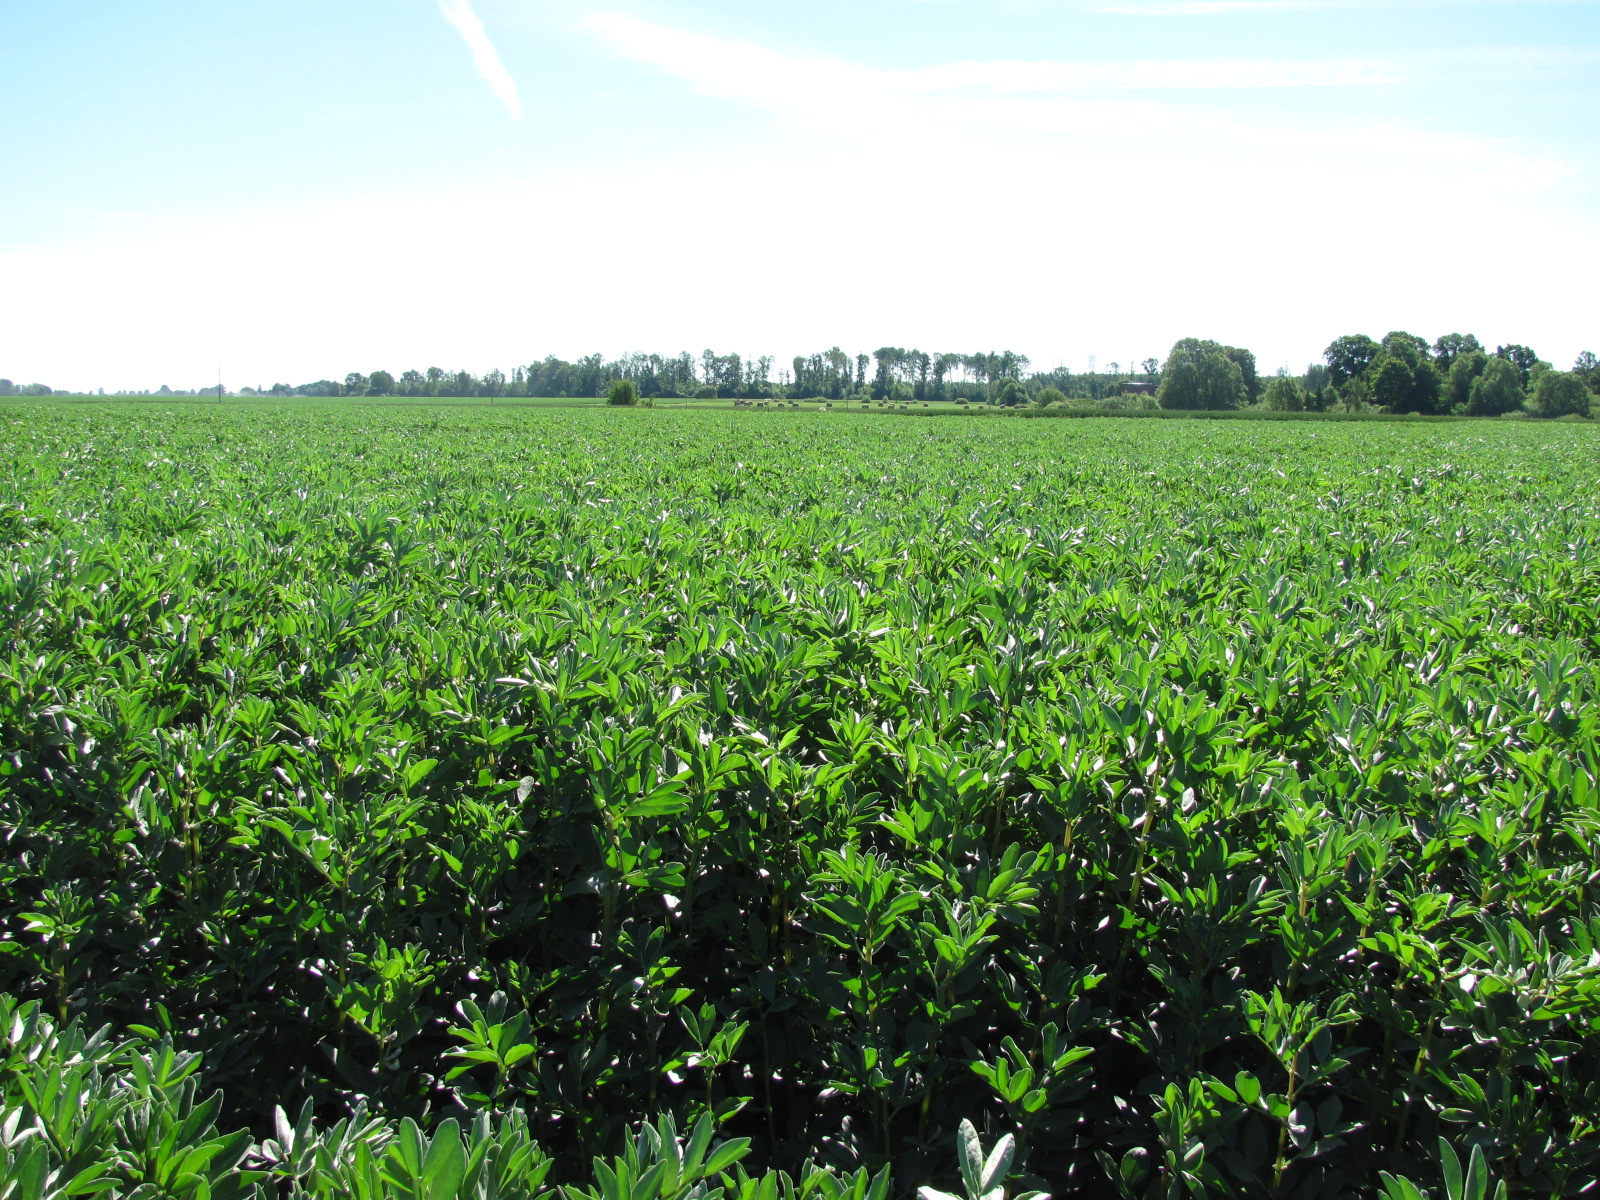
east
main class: Cropland
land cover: Dry pulses
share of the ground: > 75 %
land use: Agriculture (excluding fallow land and kitchen gardens)
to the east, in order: Dry pulses
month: July
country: LV
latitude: 56.4685
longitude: 23.8964
